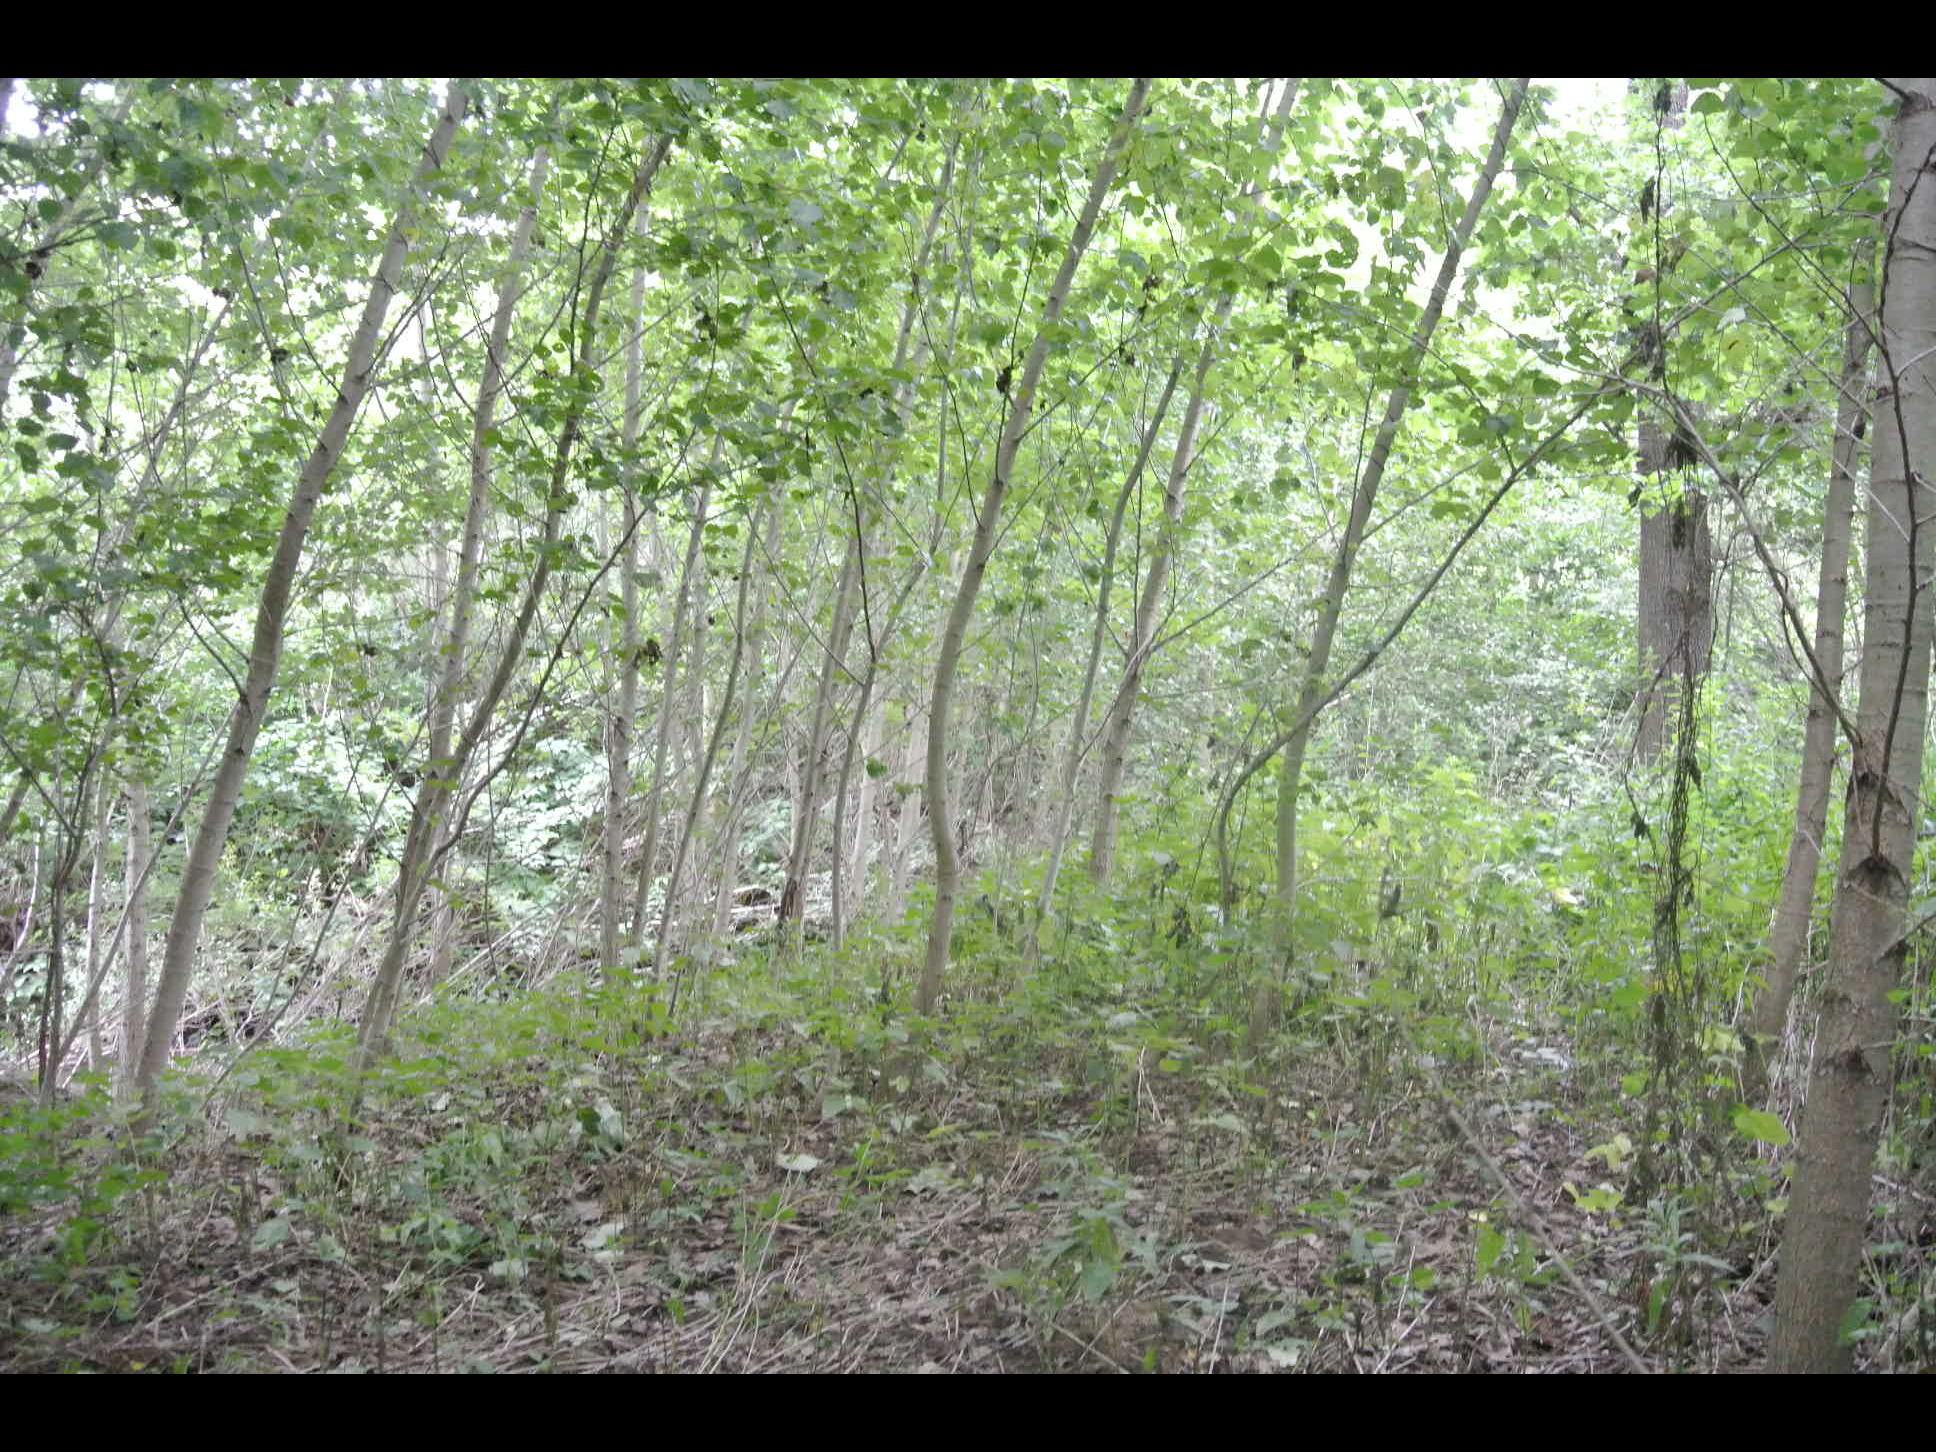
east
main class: Woodland
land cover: Broadleaved woodland
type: floodplain forest
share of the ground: > 75 %
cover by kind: broadleaved forest trees 100 %
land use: Forestry
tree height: > 5 m
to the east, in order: Broadleaved woodland; Inland fresh running water; Broadleaved woodland; Shruby margins; Rape and turnip rape
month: July
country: AT
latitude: 47.4677
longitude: 16.5712
